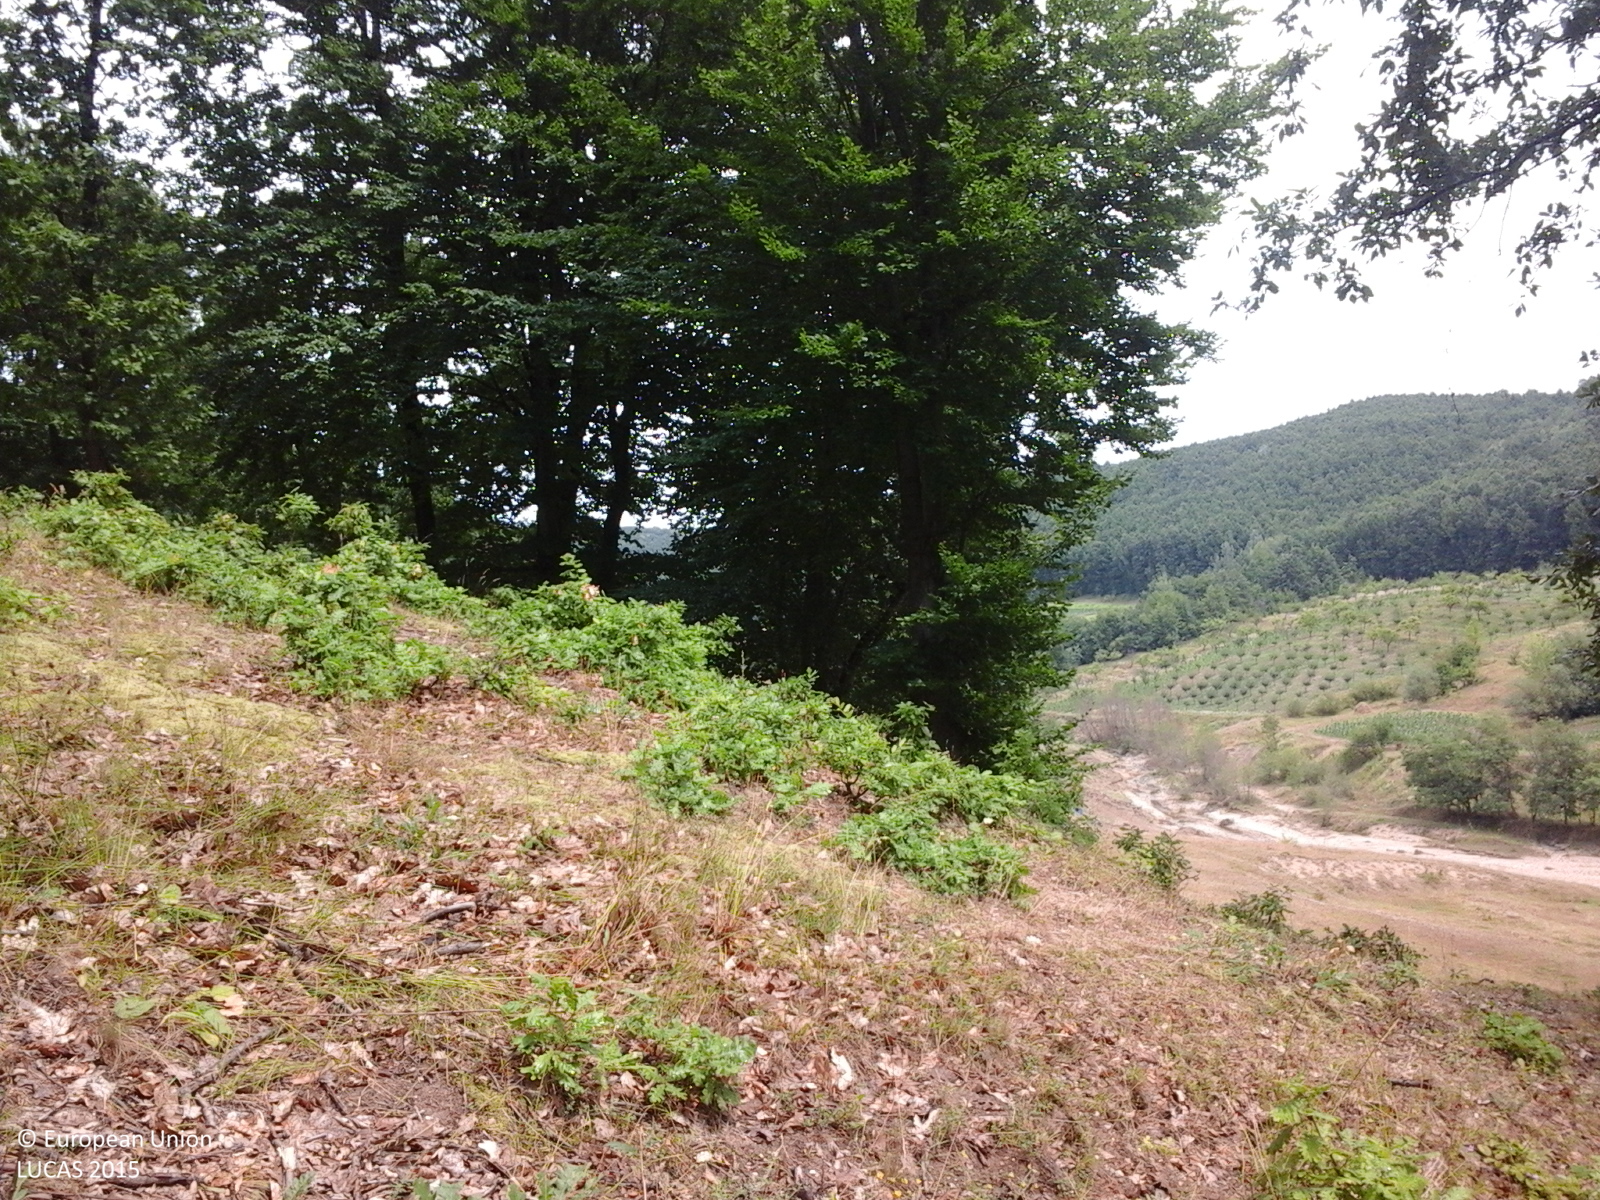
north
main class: Woodland
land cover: Broadleaved woodland
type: acidophilous oak and oak-birch forest
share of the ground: > 75 %
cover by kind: broadleaved forest trees 90 %, herbaceous plants 10 %
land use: Forestry
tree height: > 5 m
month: July
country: RO
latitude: 44.8395
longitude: 24.4053
